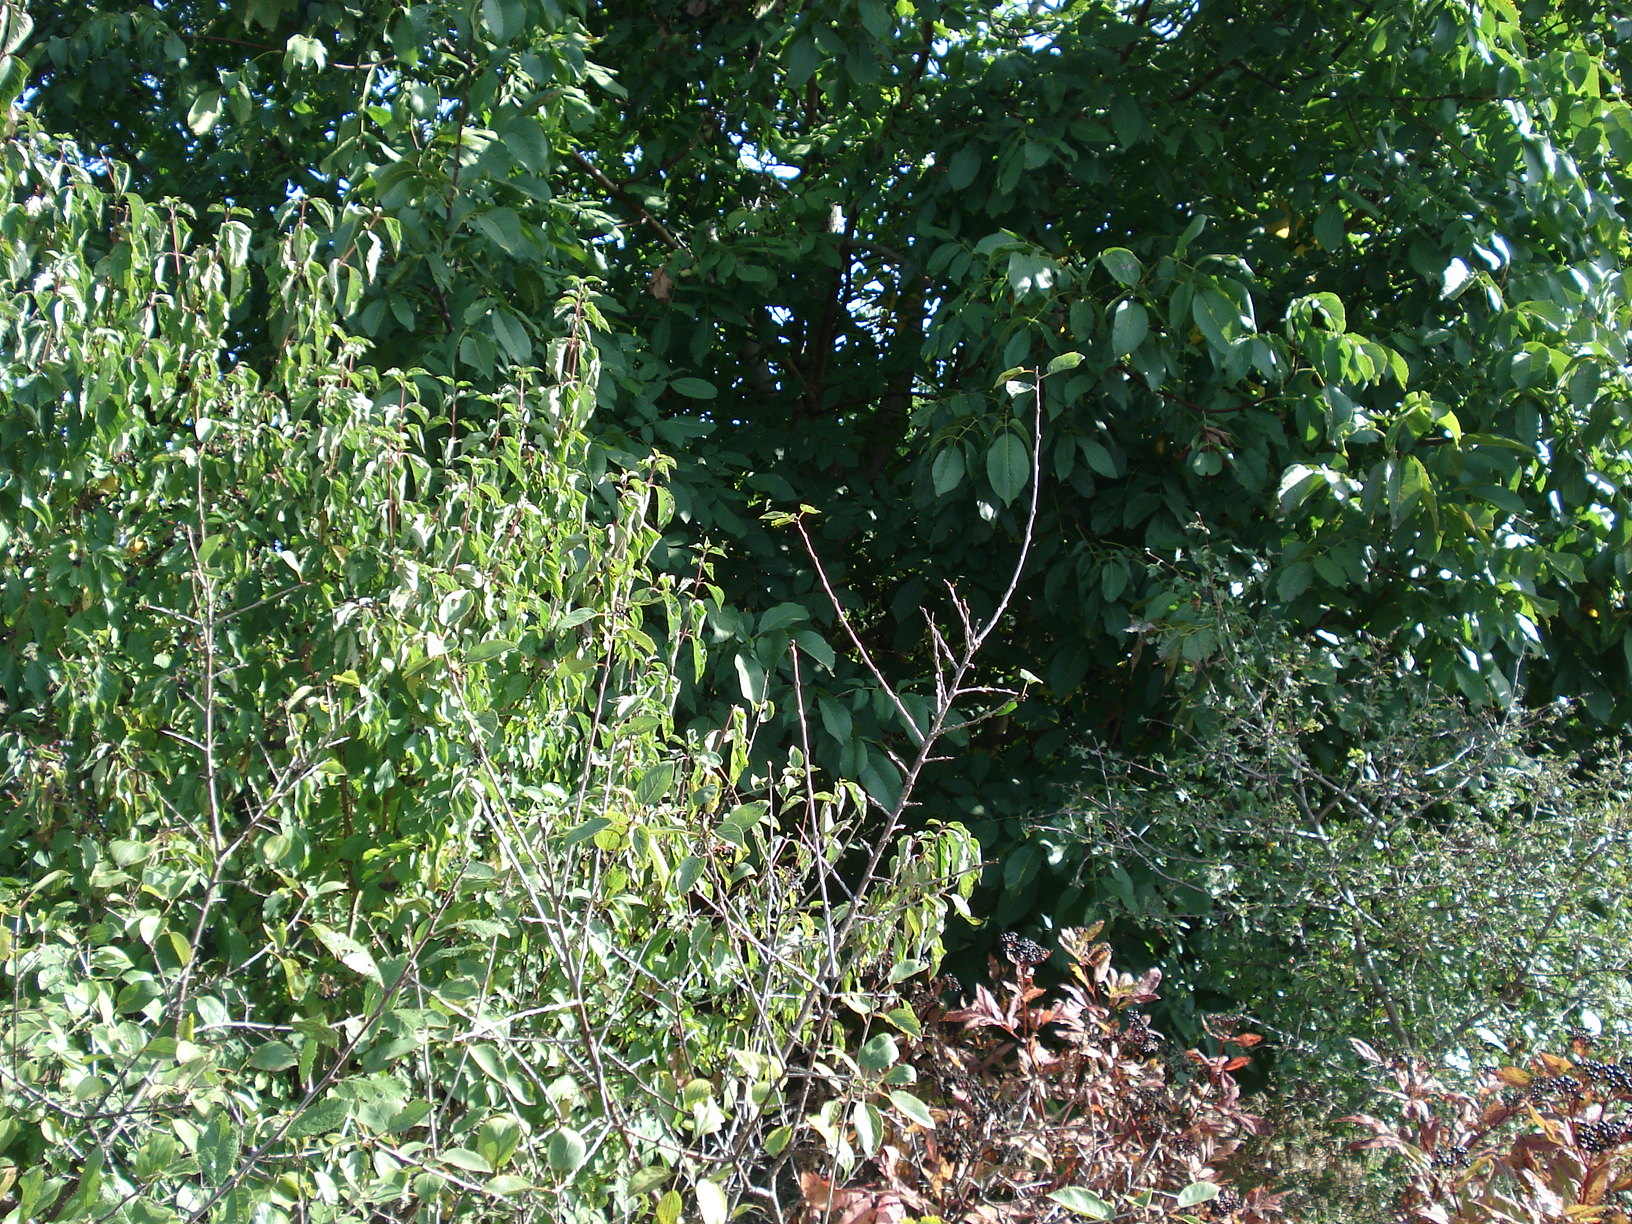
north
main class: Grassland
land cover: Spontaneously vegetated surfaces
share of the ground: > 75 %
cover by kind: herbaceous plants 100 %
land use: Fallow land
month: September
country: BG
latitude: 43.2490
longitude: 25.5117
